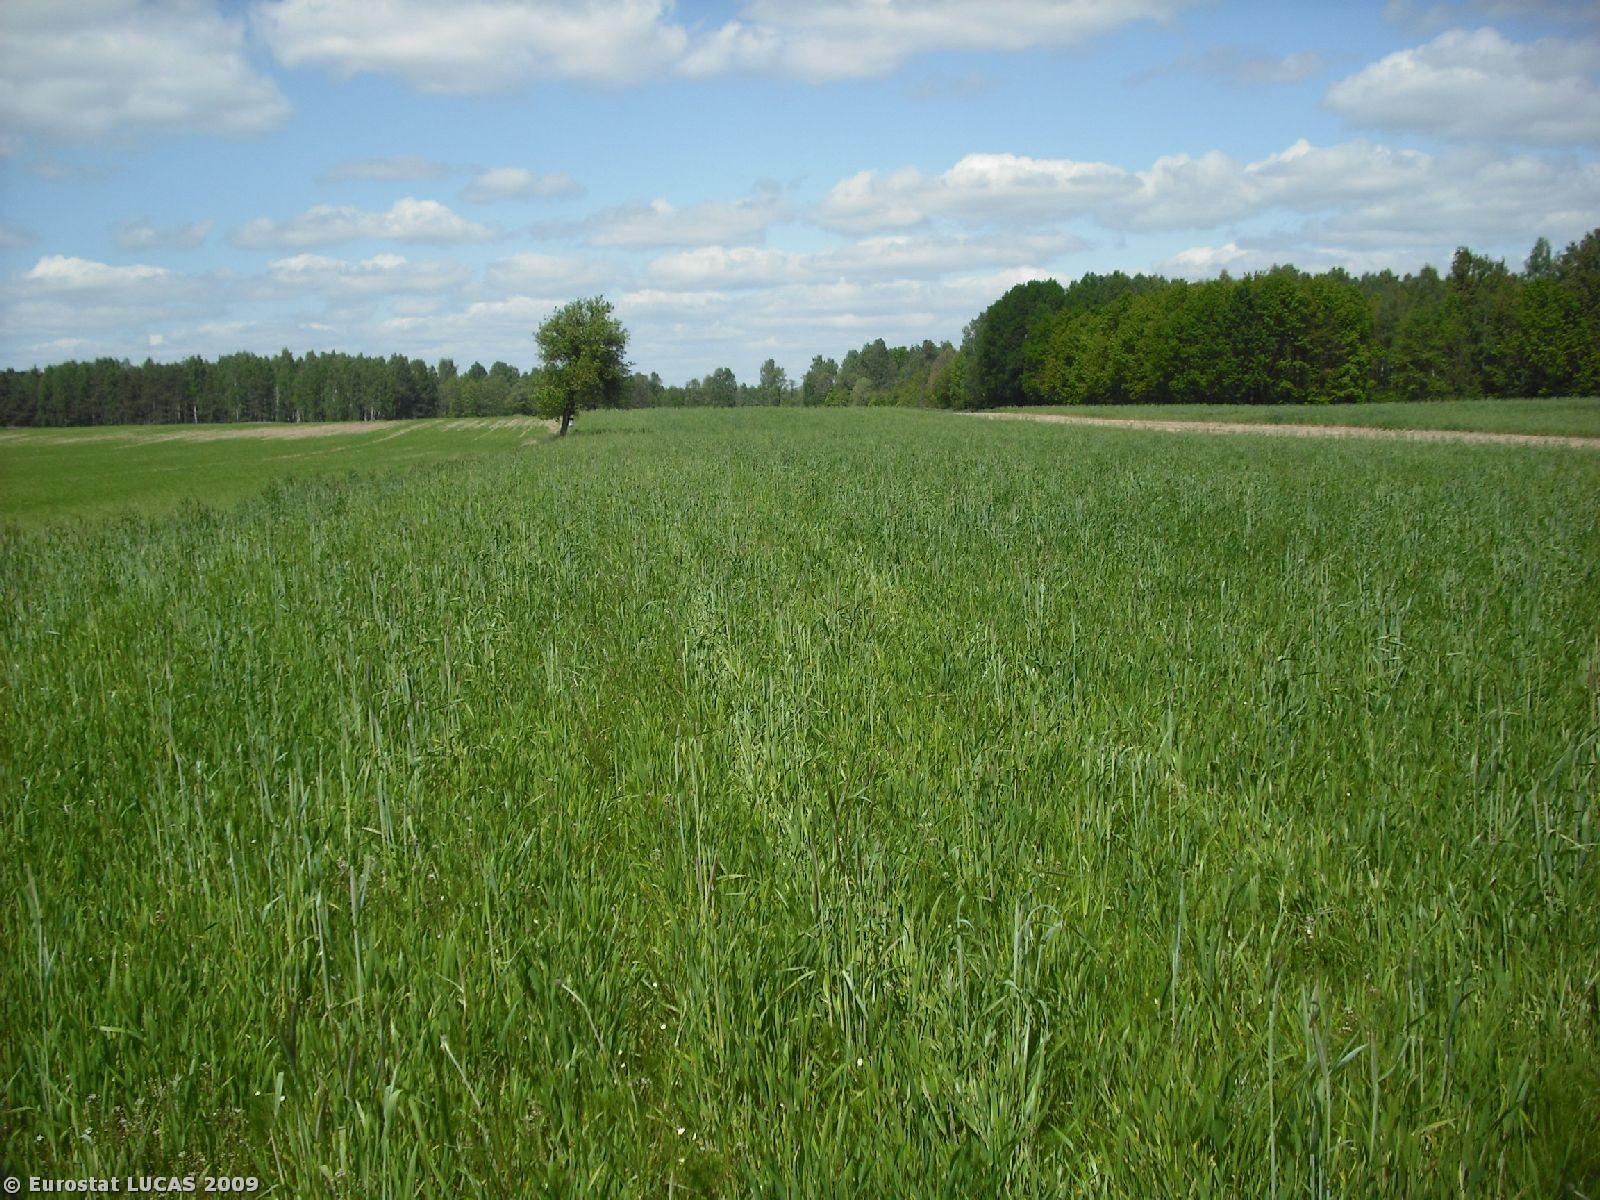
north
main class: Cropland
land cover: Triticale
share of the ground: > 75 %
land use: Agriculture (excluding fallow land and kitchen gardens)
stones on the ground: < 10 %
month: May
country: PL
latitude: 52.9020
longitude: 22.4493
